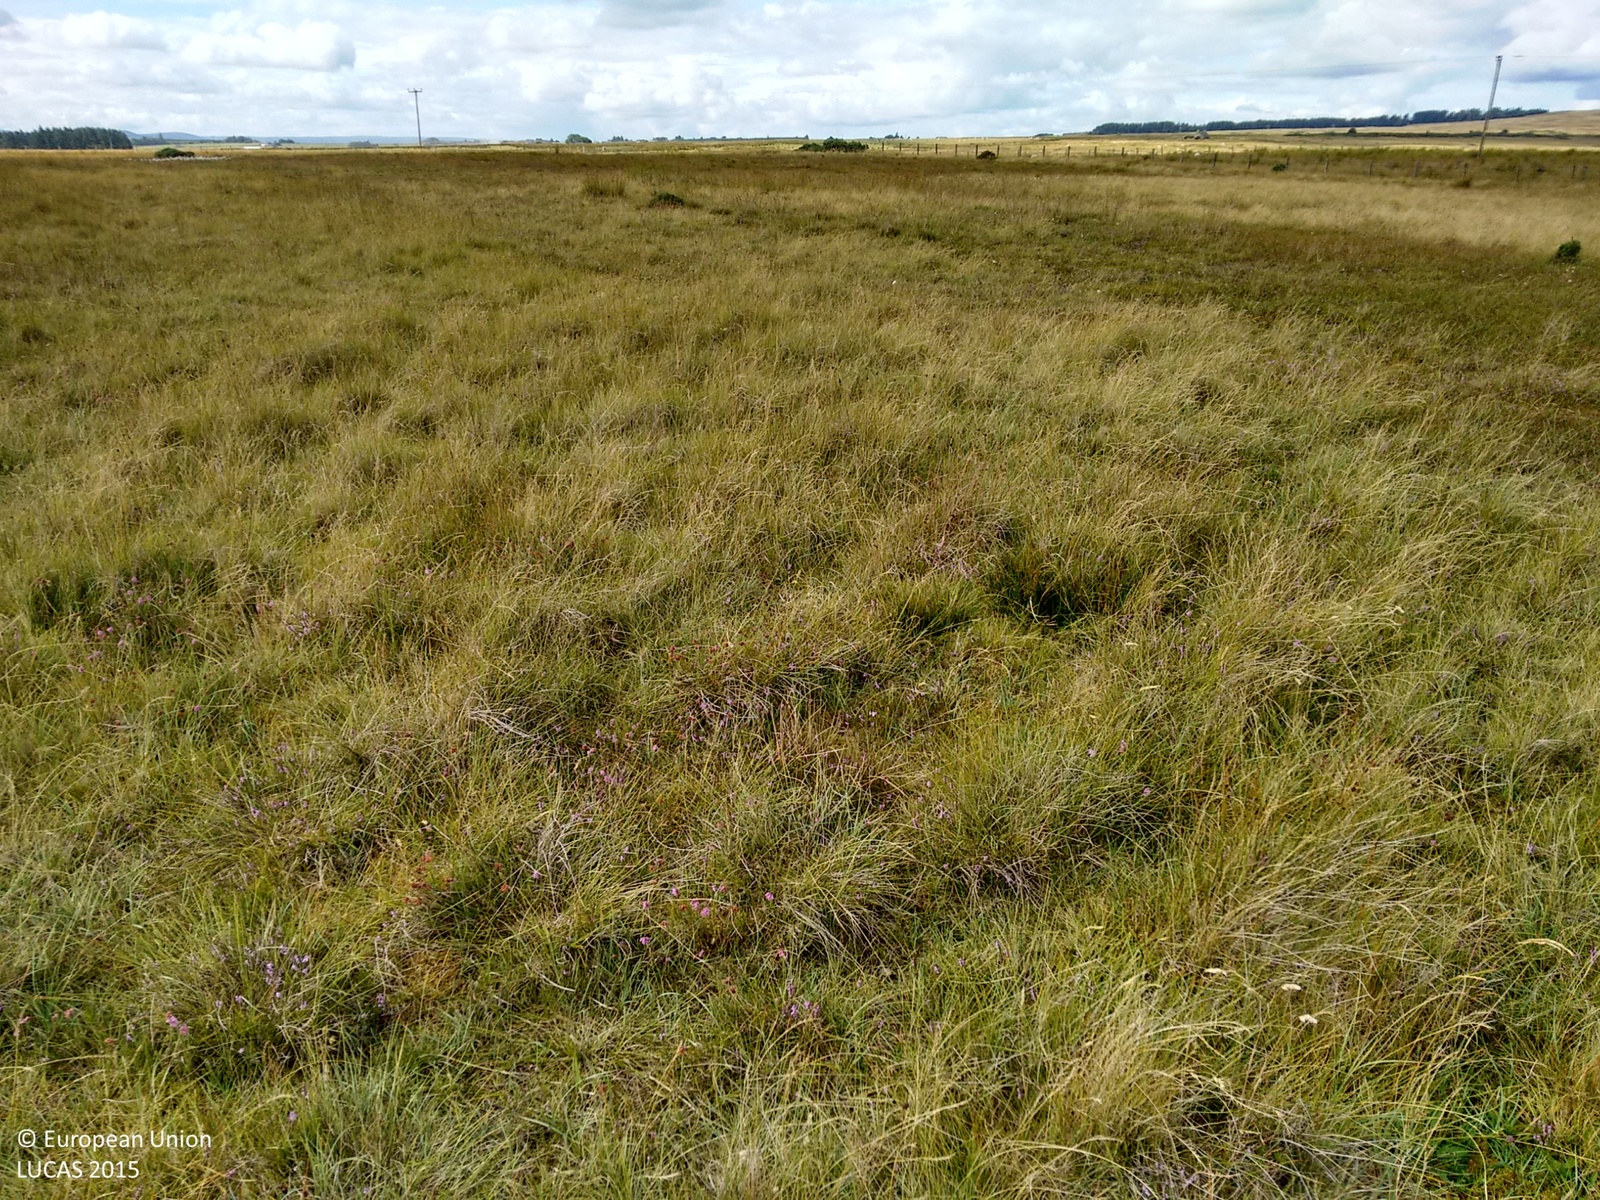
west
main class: Grassland
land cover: Grassland without tree/shrub cover
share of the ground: > 75 %
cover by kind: herbaceous plants 95 %, shrubs 5 %
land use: Agriculture (excluding fallow land and kitchen gardens)
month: August
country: GB
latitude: 58.4778
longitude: -3.3870
